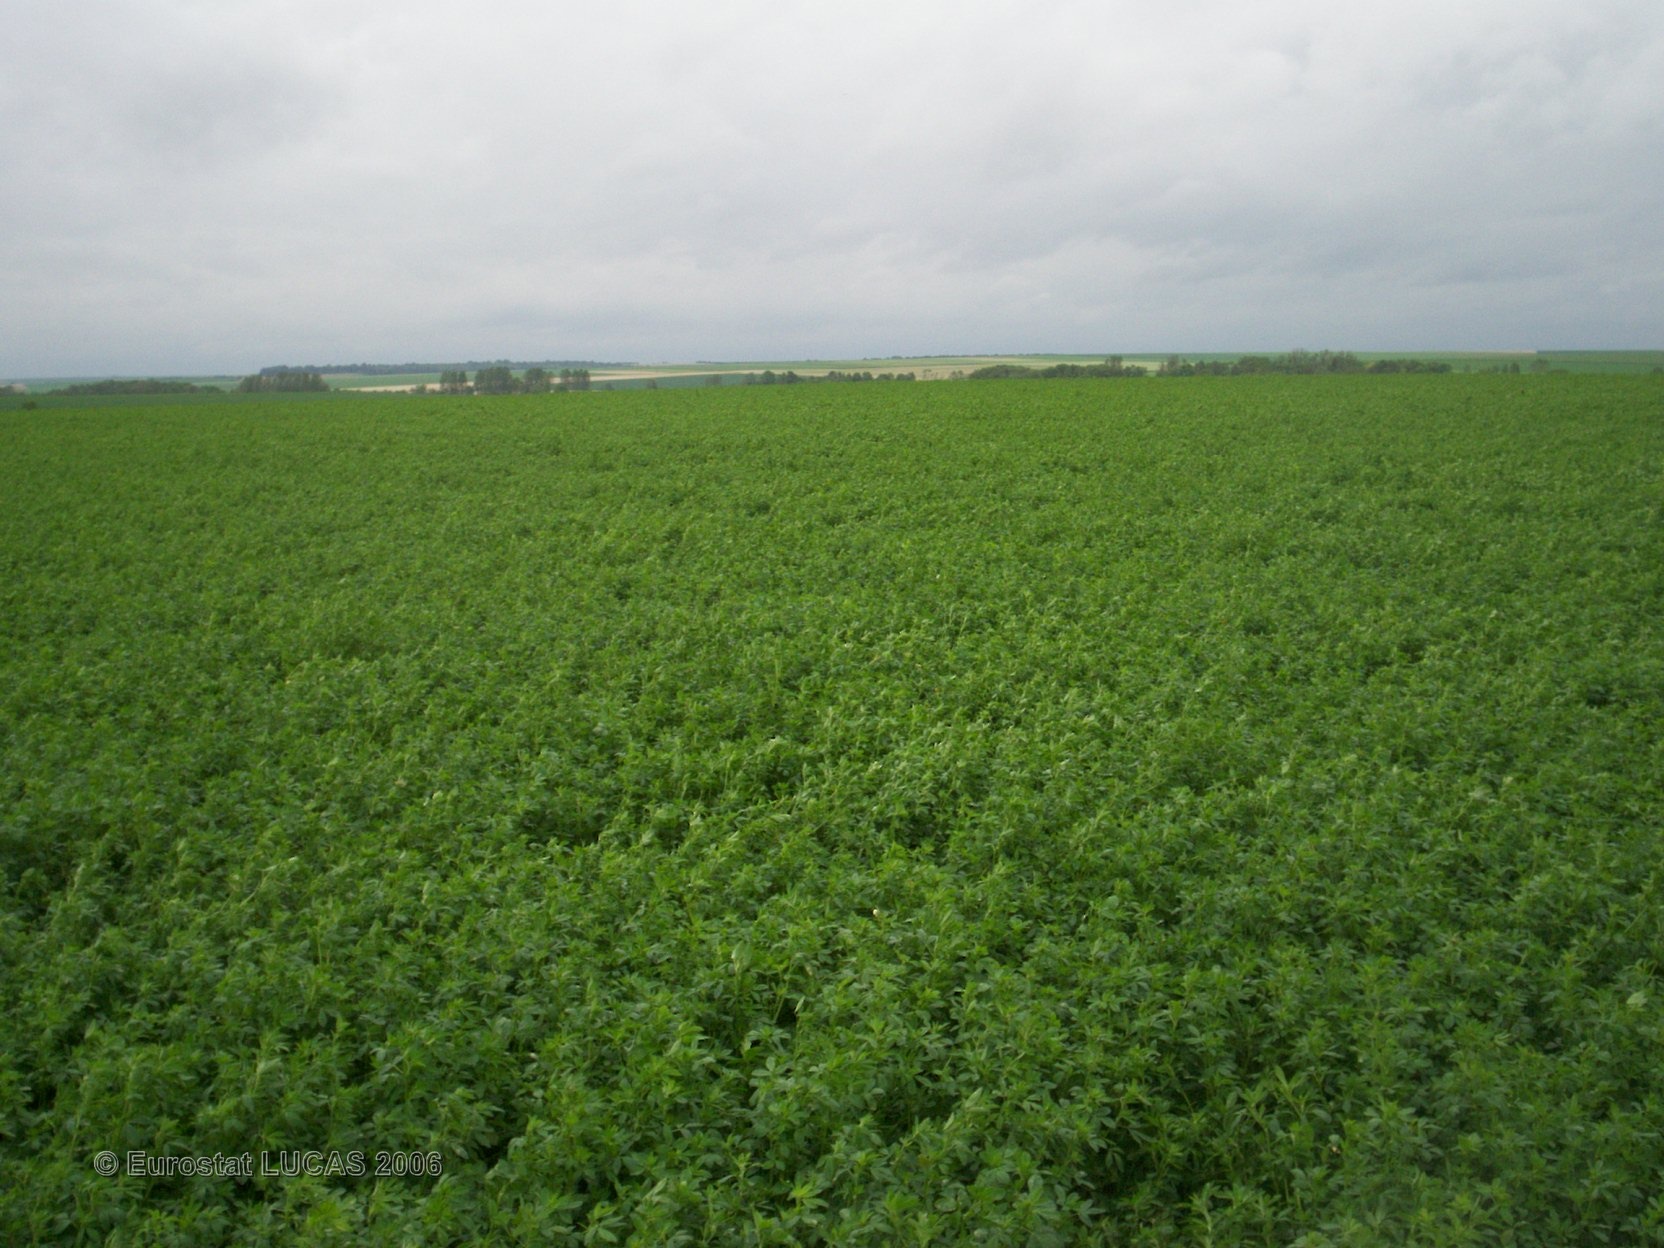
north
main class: Cropland
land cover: Lucerne
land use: Agriculture (excluding fallow land and kitchen gardens)
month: May
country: FR
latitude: 49.3943
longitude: 4.3330
